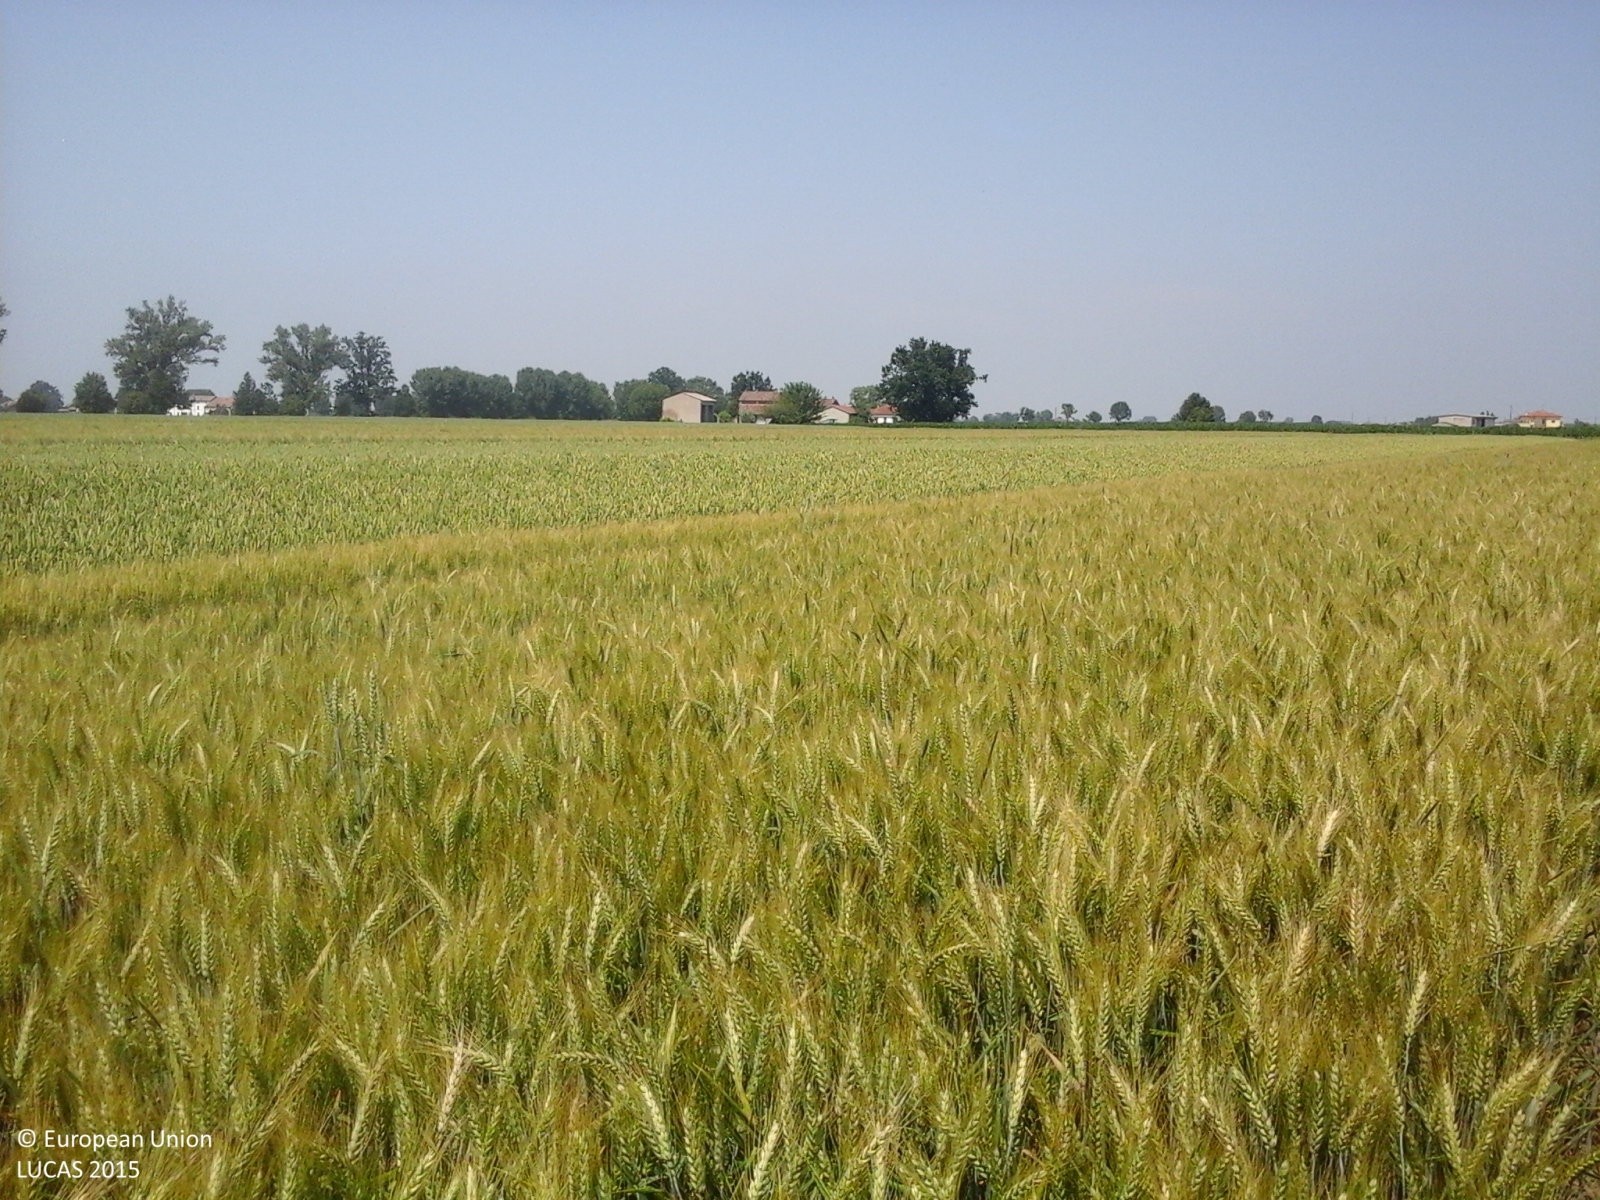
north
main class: Cropland
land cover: Common wheat
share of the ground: > 75 %
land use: Agriculture (excluding fallow land and kitchen gardens)
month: June
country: IT
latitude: 44.9636
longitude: 10.0633
